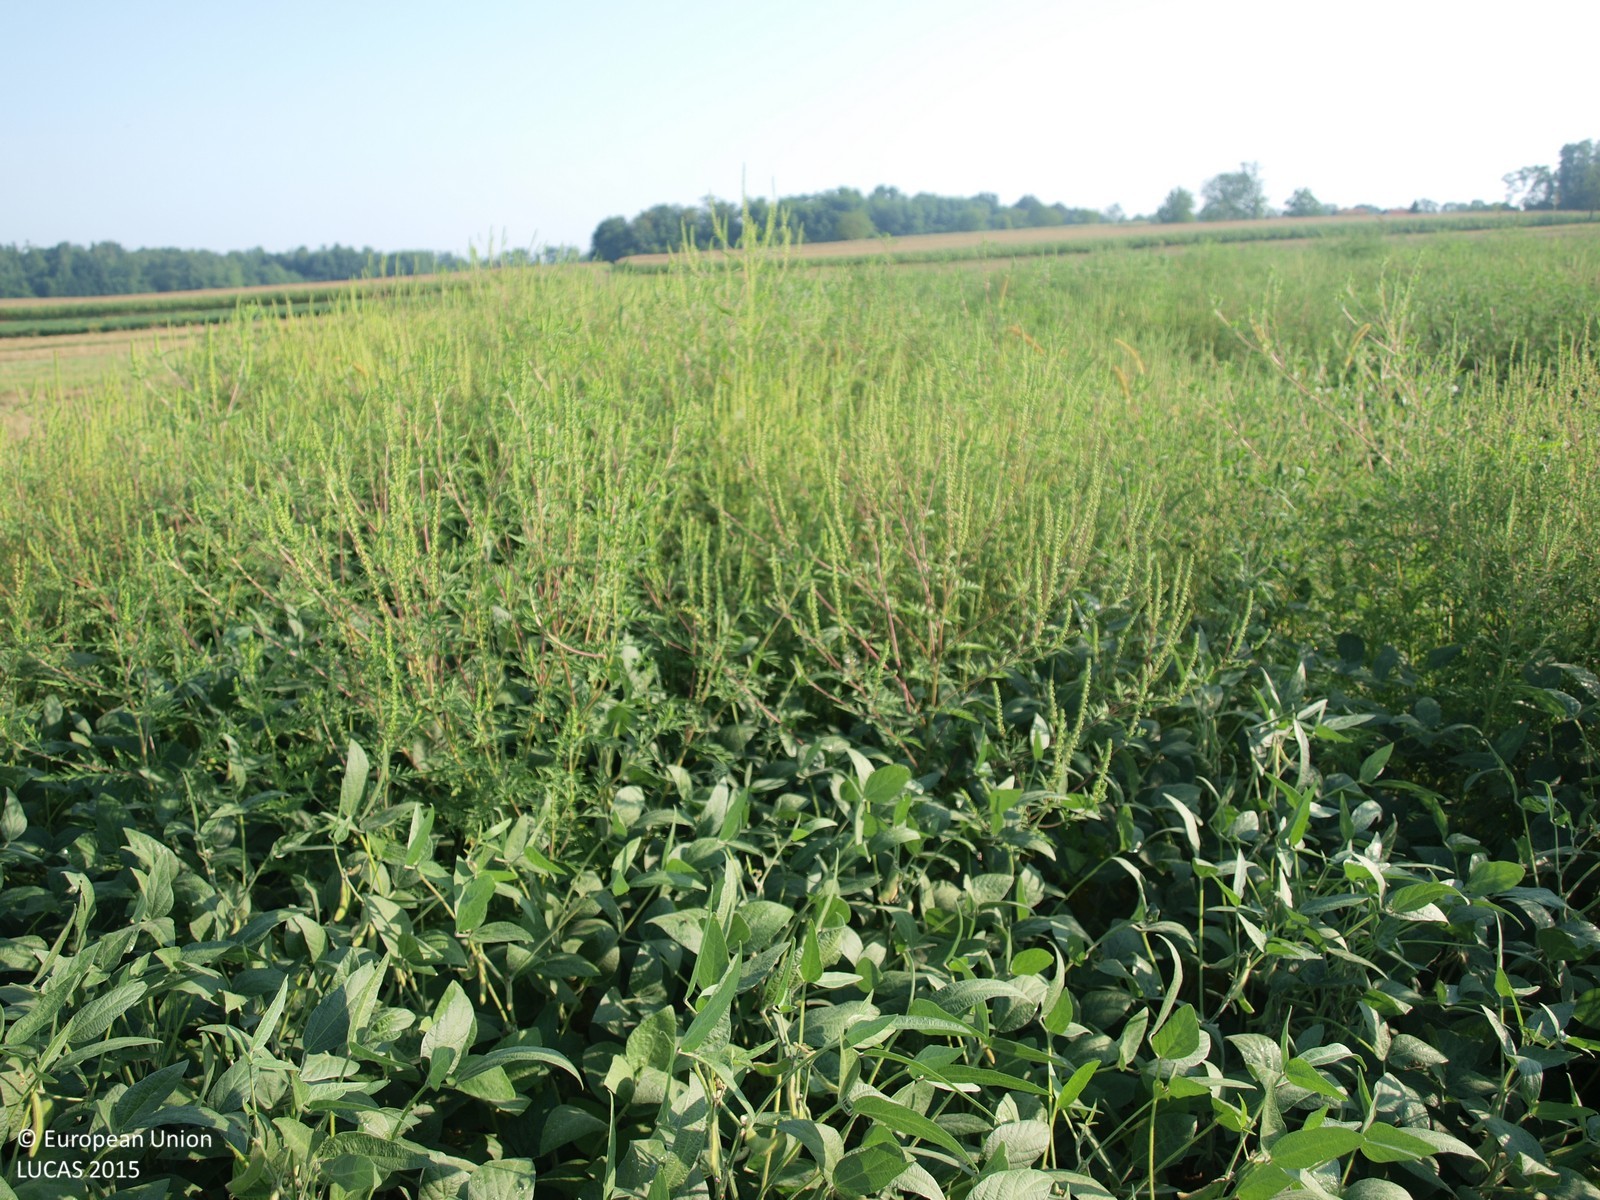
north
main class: Cropland
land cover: Soya
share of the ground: > 75 %
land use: Agriculture (excluding fallow land and kitchen gardens)
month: August
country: HR
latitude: 45.9553
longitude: 16.4893
